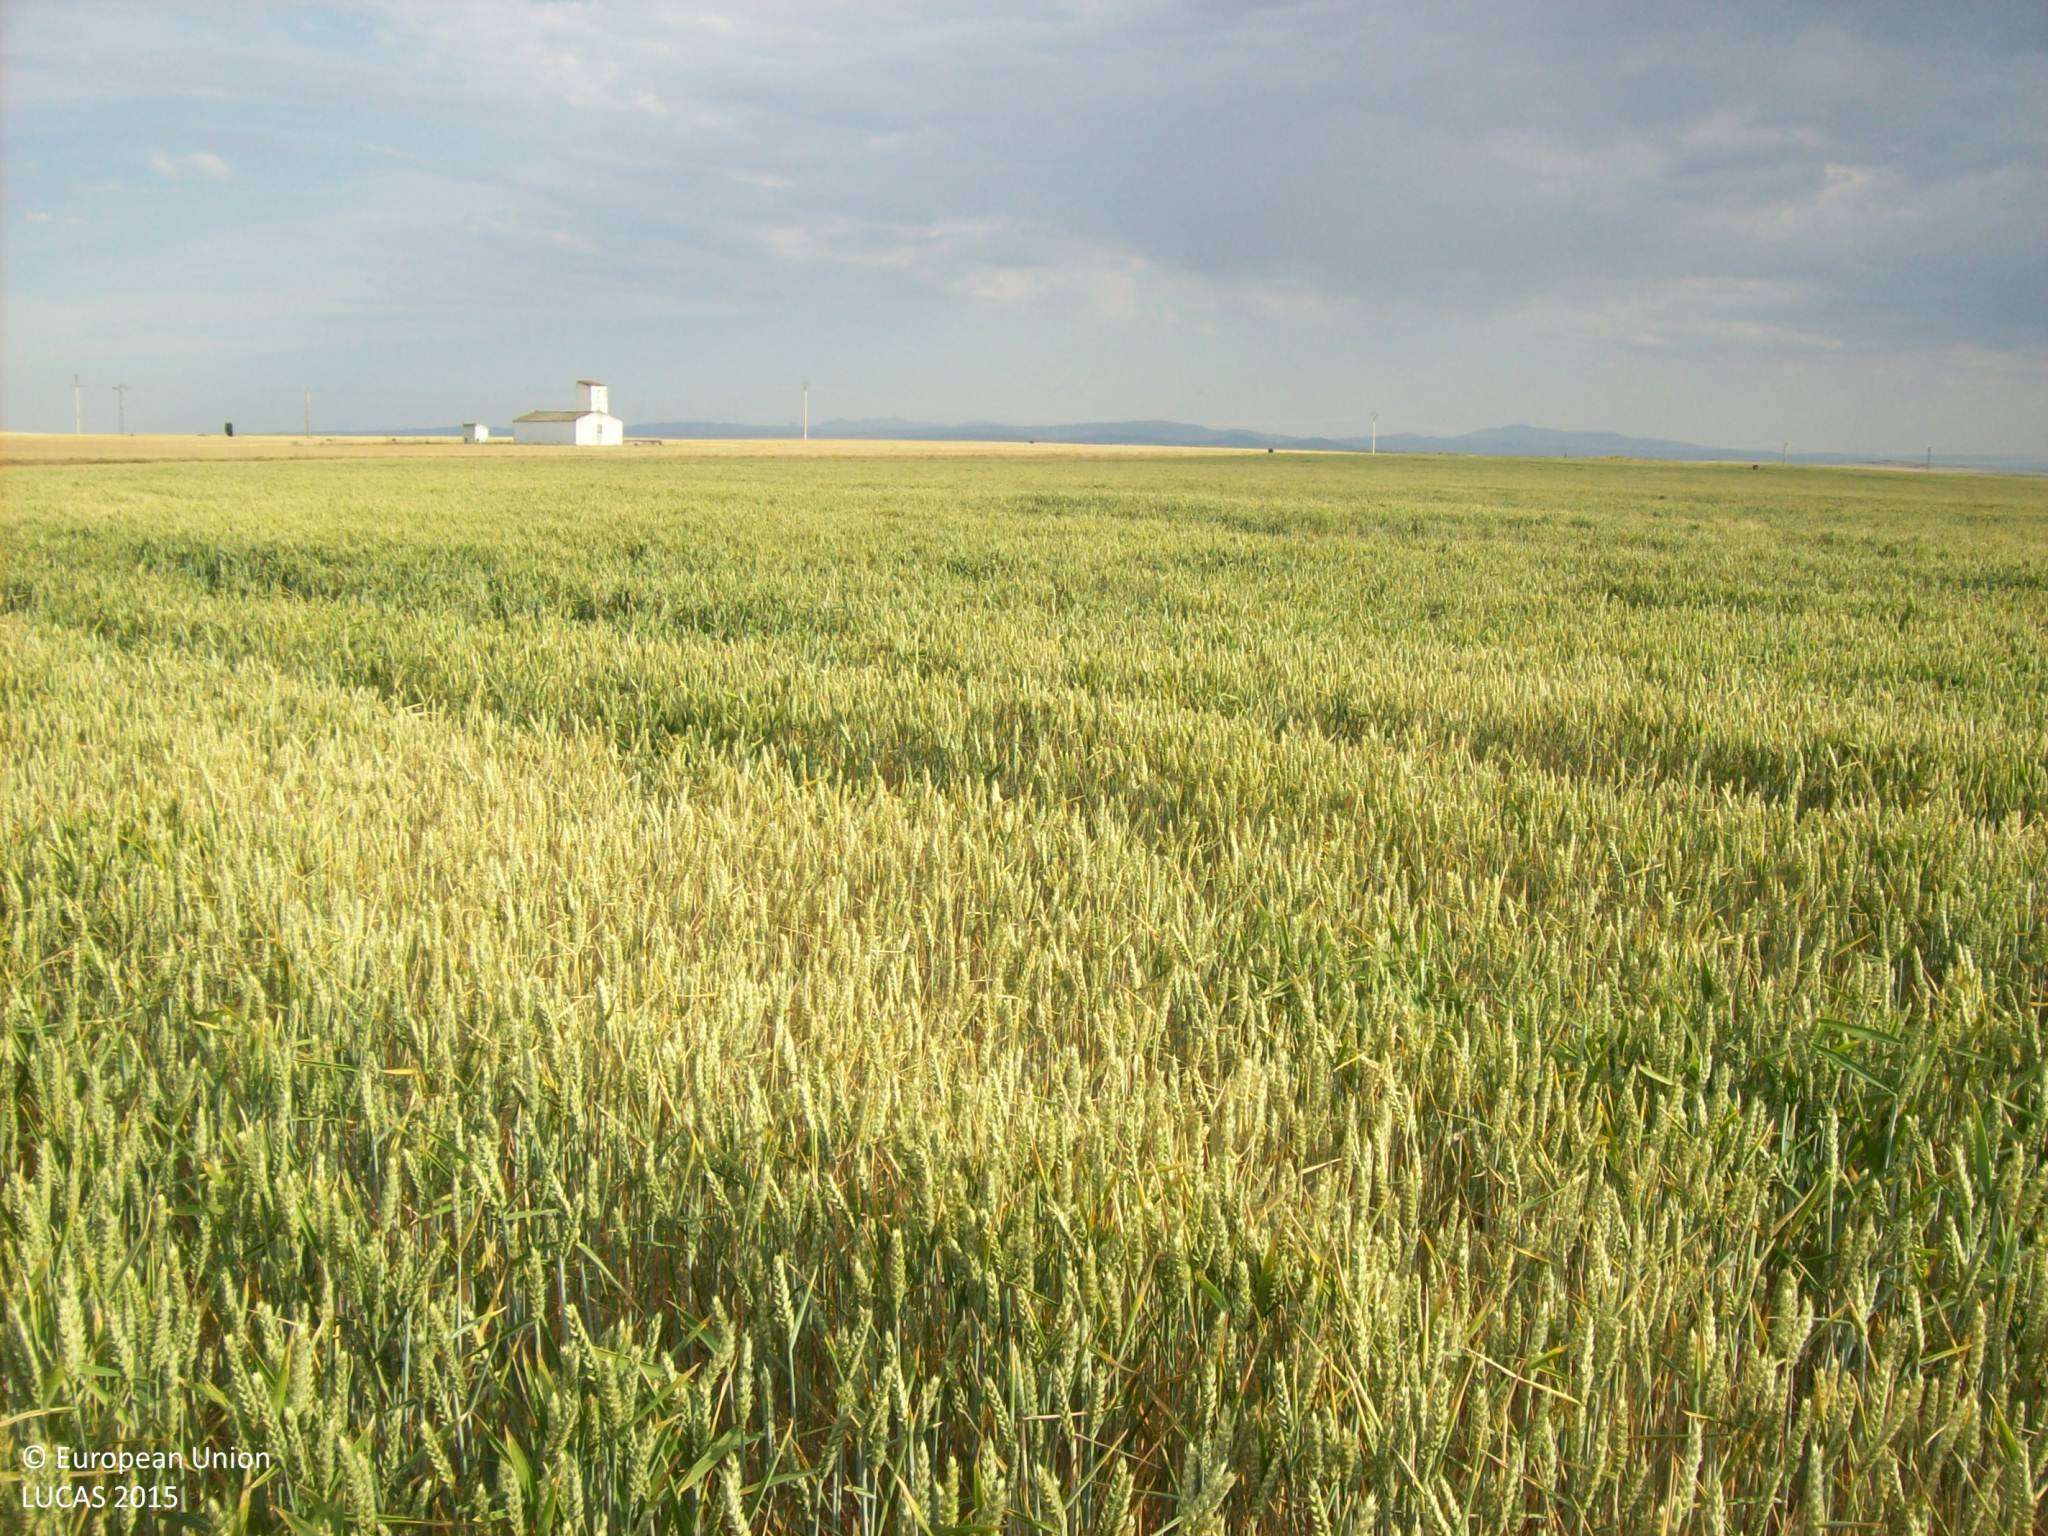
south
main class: Cropland
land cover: Common wheat
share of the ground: > 75 %
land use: Agriculture (excluding fallow land and kitchen gardens)
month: June
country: ES
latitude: 41.0459
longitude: -5.0448
